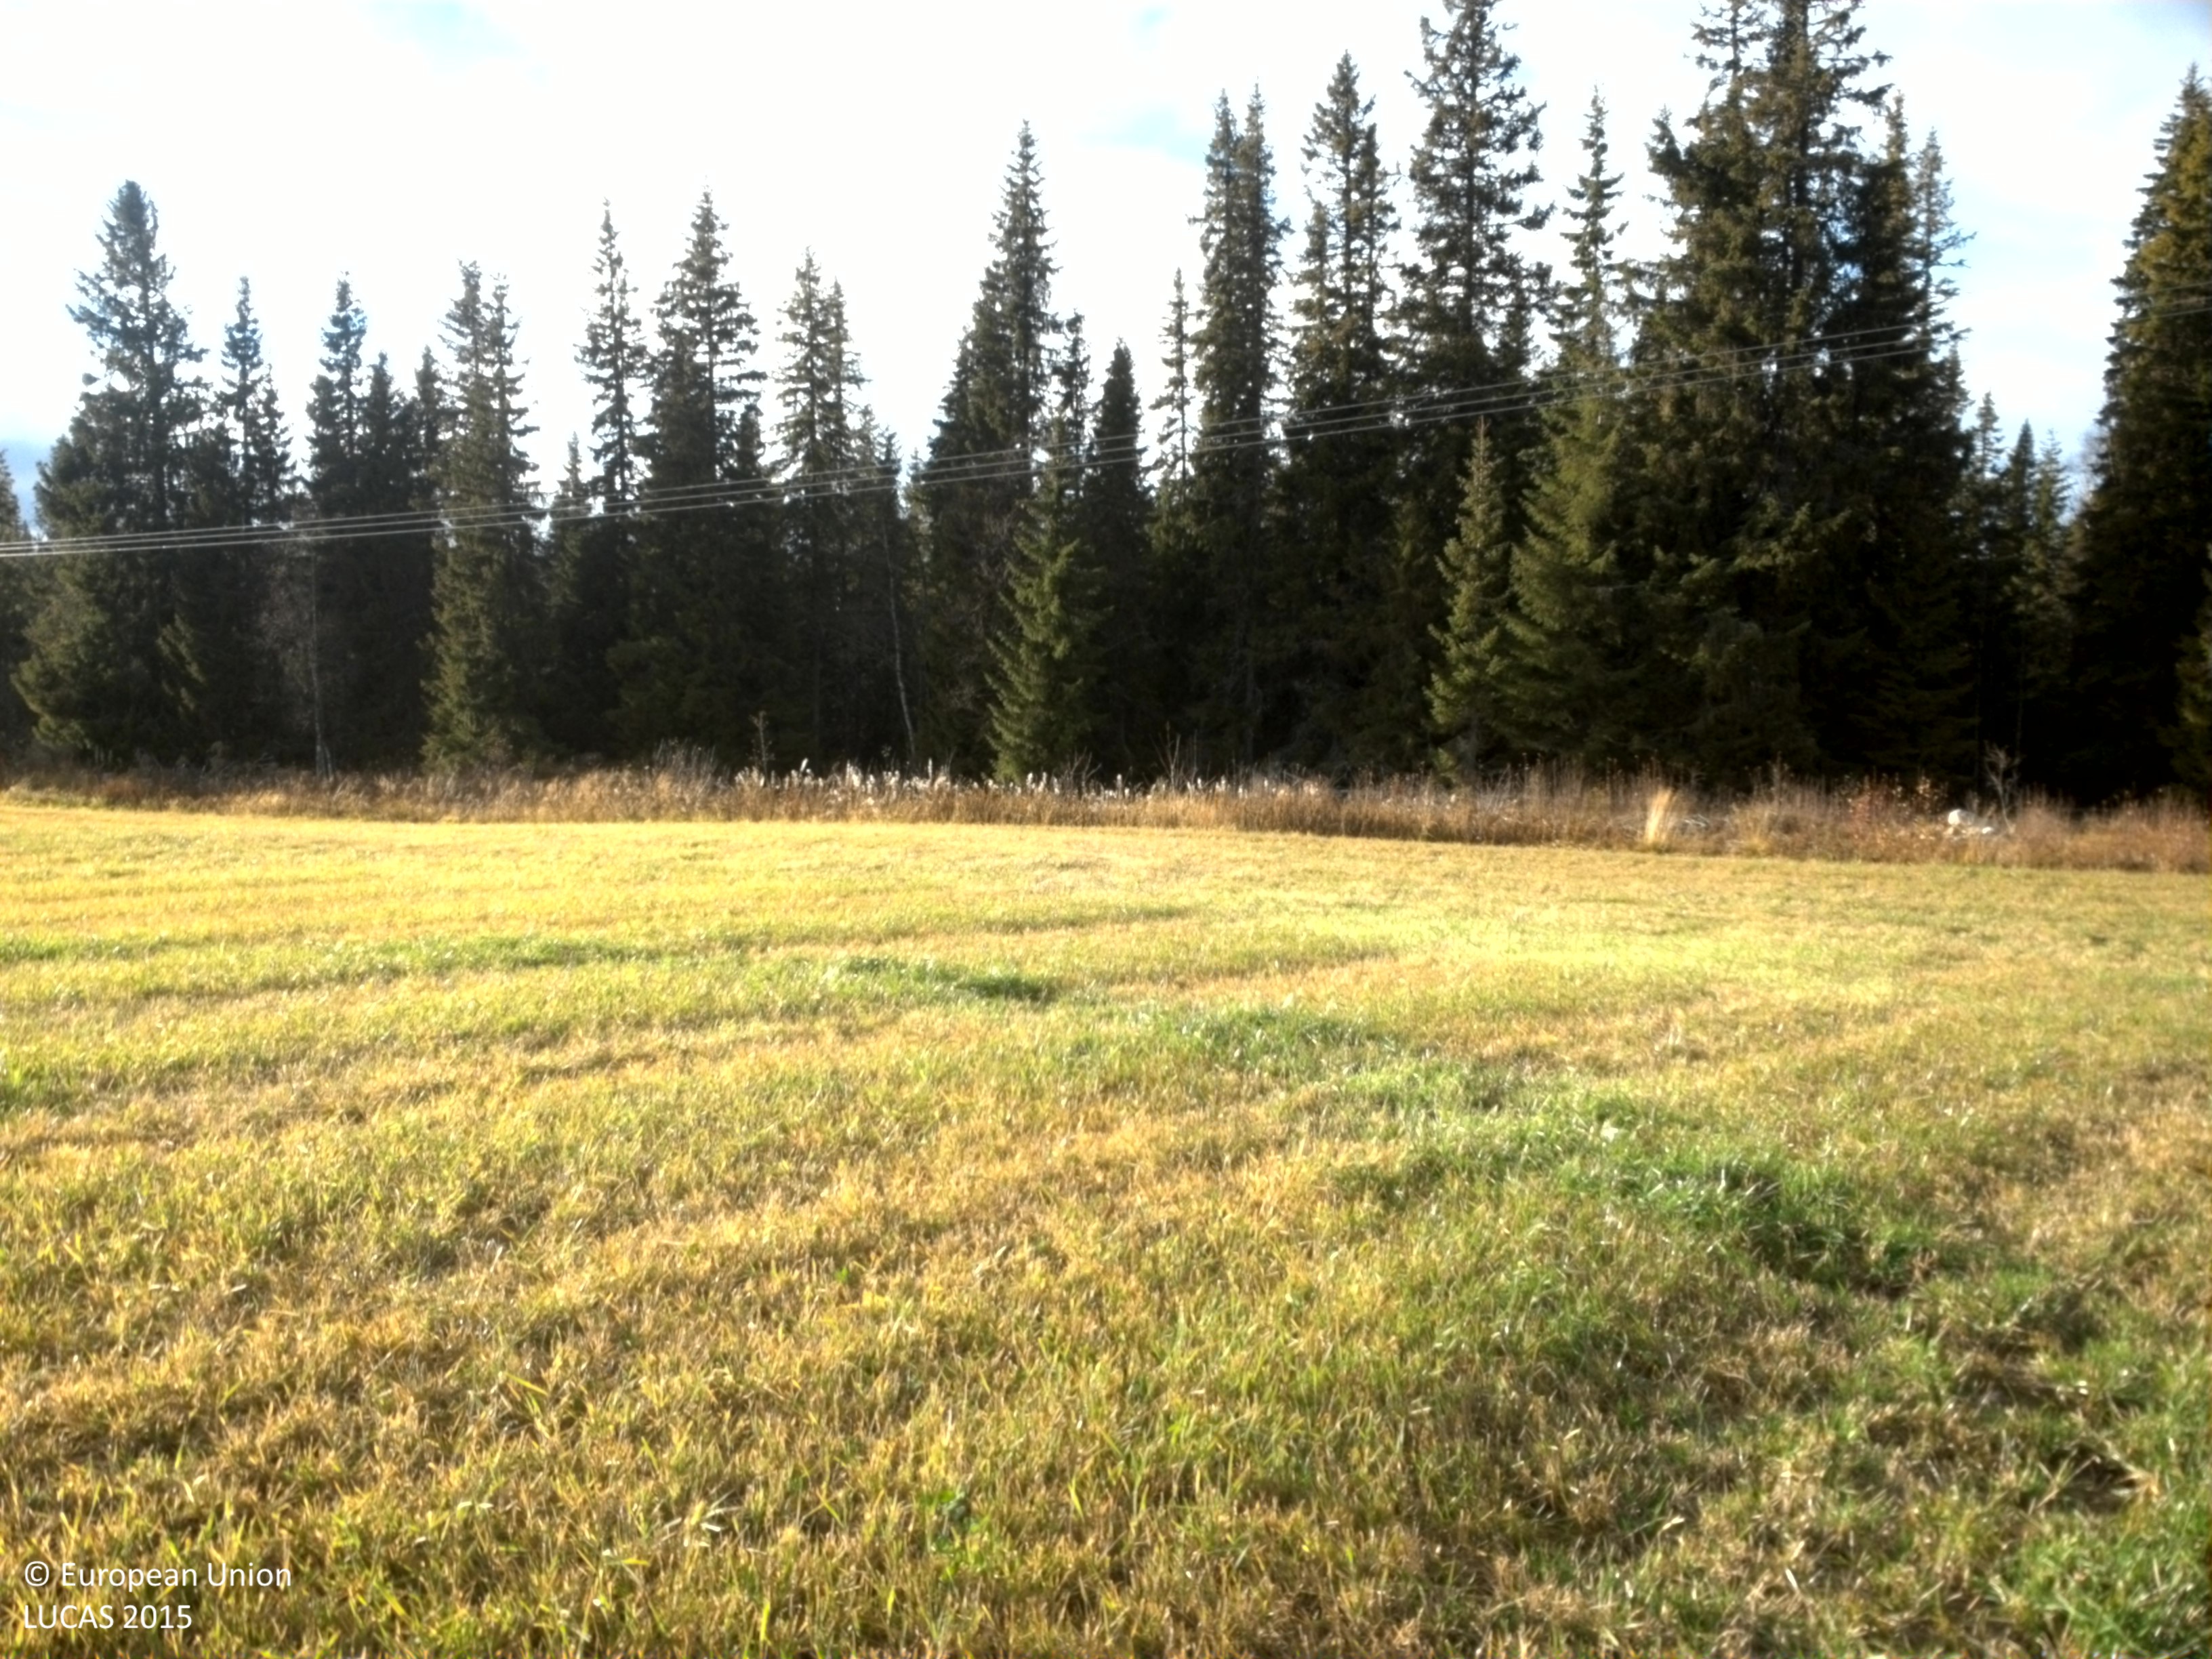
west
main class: Grassland
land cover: Grassland without tree/shrub cover
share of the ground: > 75 %
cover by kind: herbaceous plants 100 %
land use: Agriculture (excluding fallow land and kitchen gardens)
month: October
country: SE
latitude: 64.5405
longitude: 16.4102
